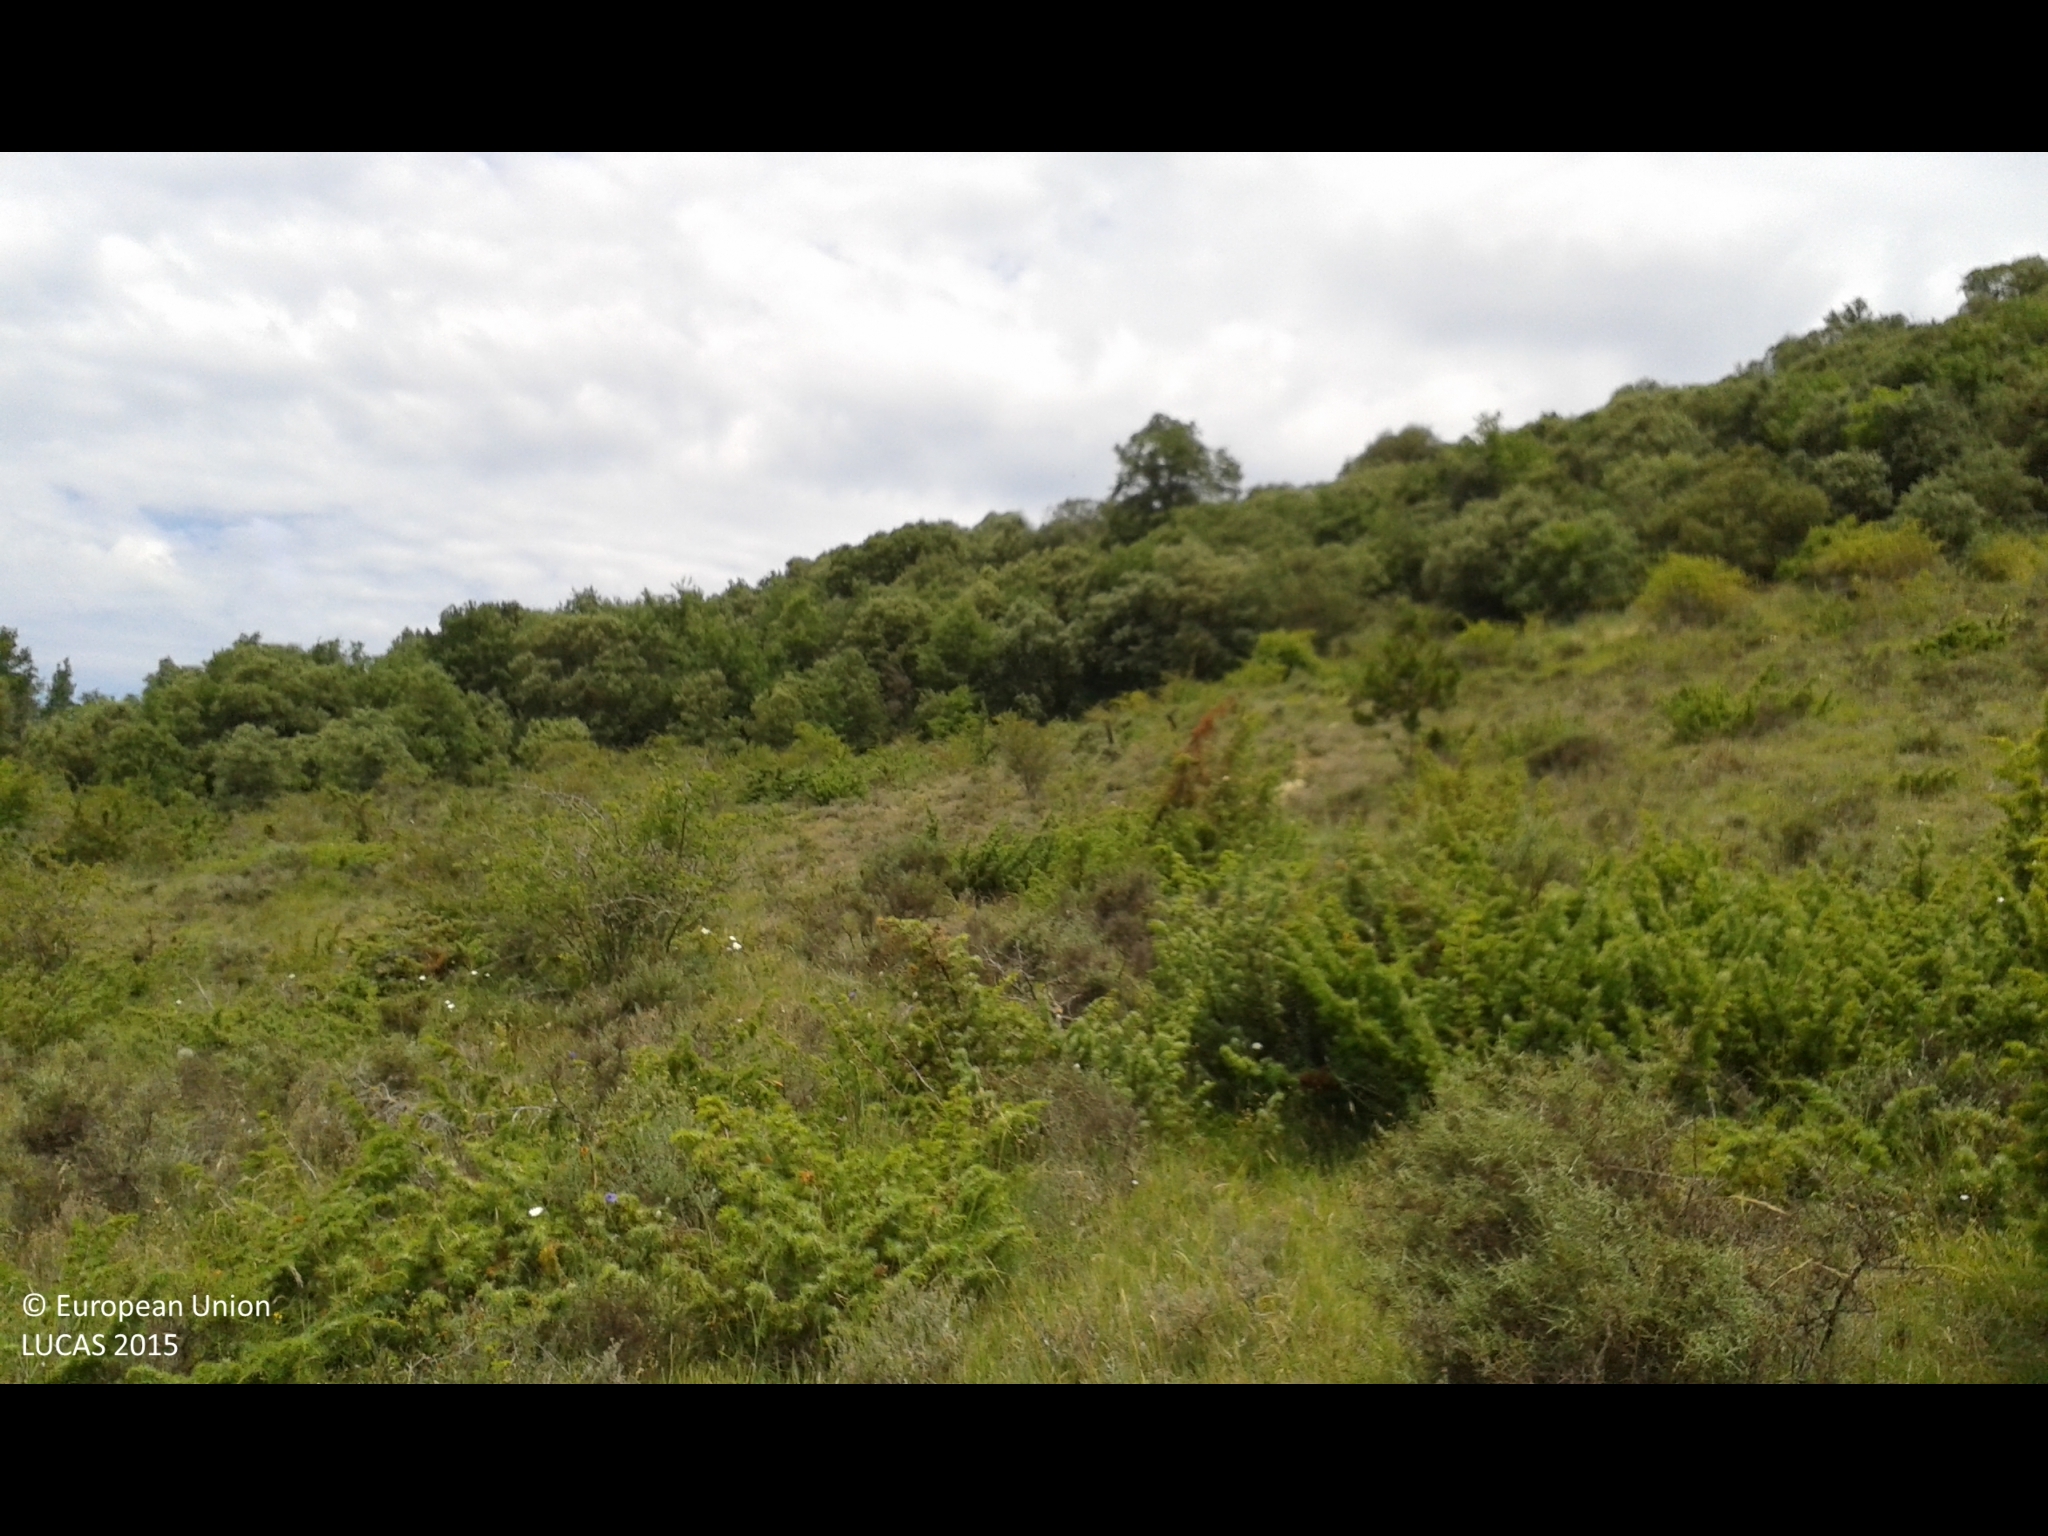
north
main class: Grassland
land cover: Grassland without tree/shrub cover
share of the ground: > 75 %
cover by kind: consolidated bare surface 60 %, herbaceous plants 40 %
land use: Community services
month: June
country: ES
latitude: 42.8510
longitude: -1.6773
